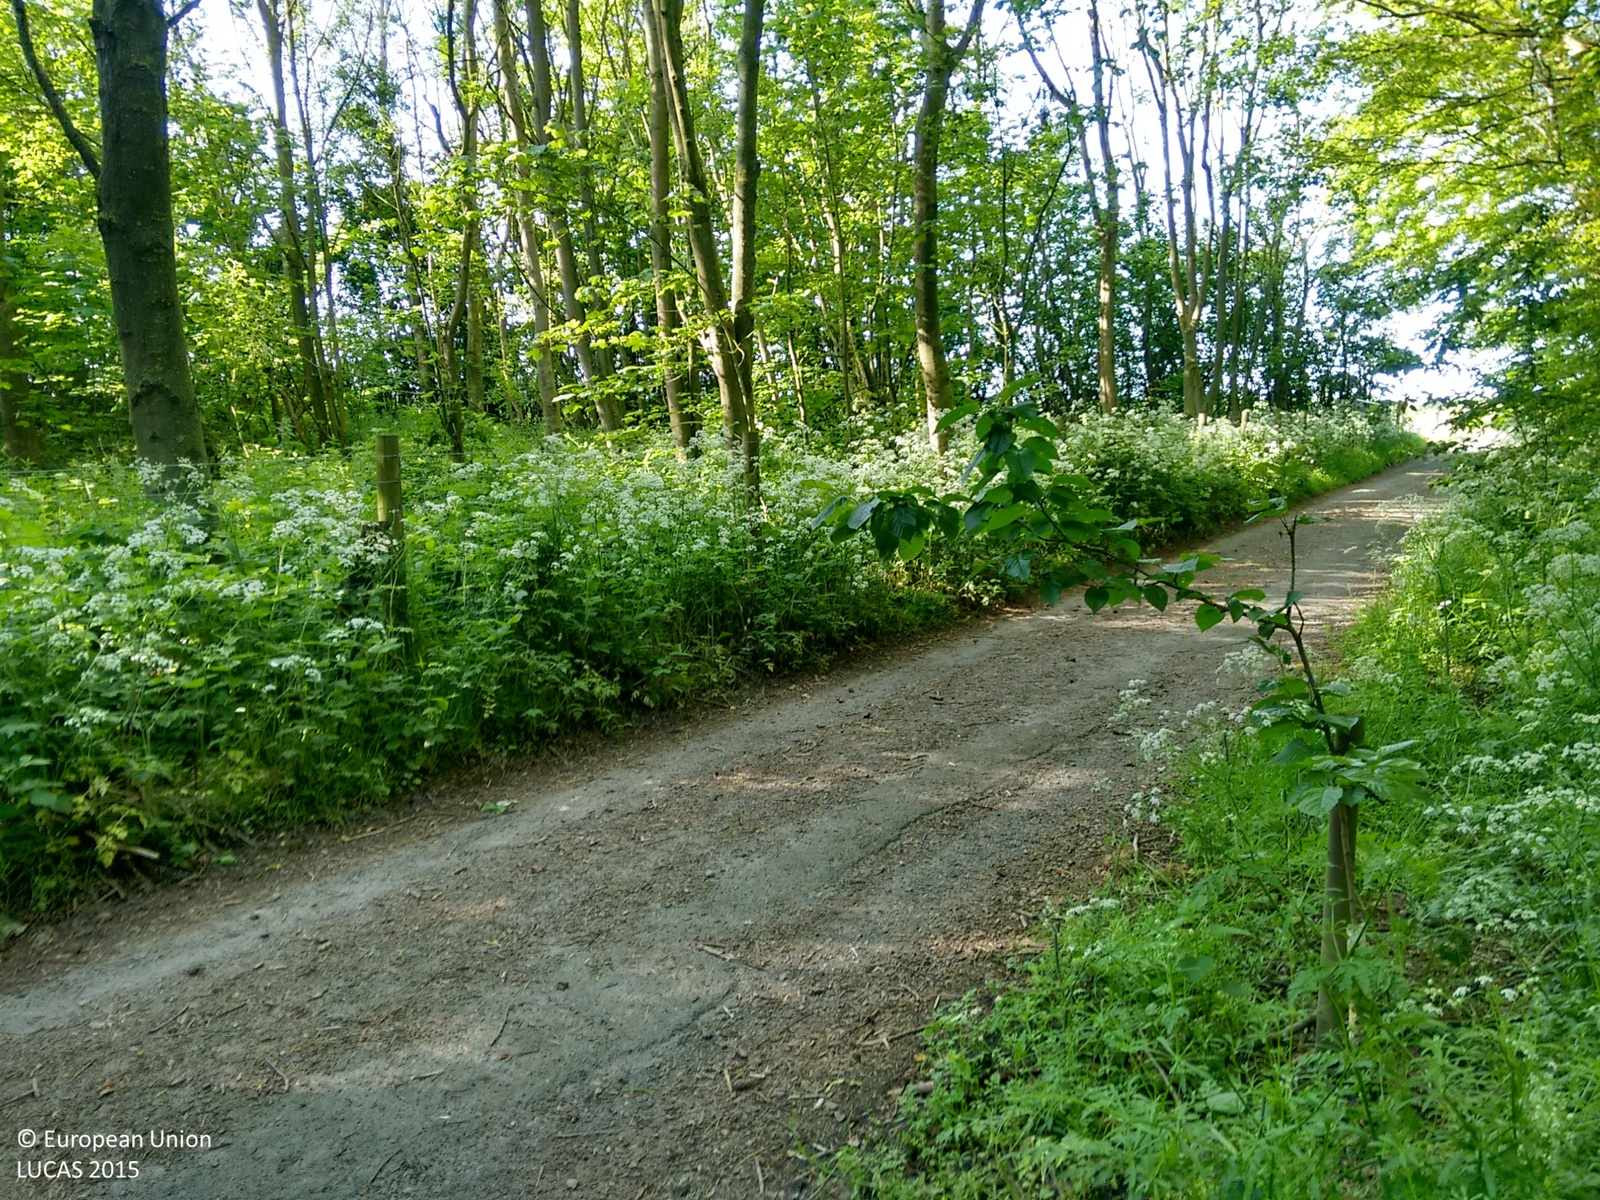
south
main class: Woodland
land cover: Broadleaved woodland
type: mesophytic deciduous forest
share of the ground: > 75 %
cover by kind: broadleaved forest trees 90 %, shrubs 10 %
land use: Amenities, museums, leisure
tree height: > 5 m
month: May
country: GB
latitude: 51.1649
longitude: 1.2121
